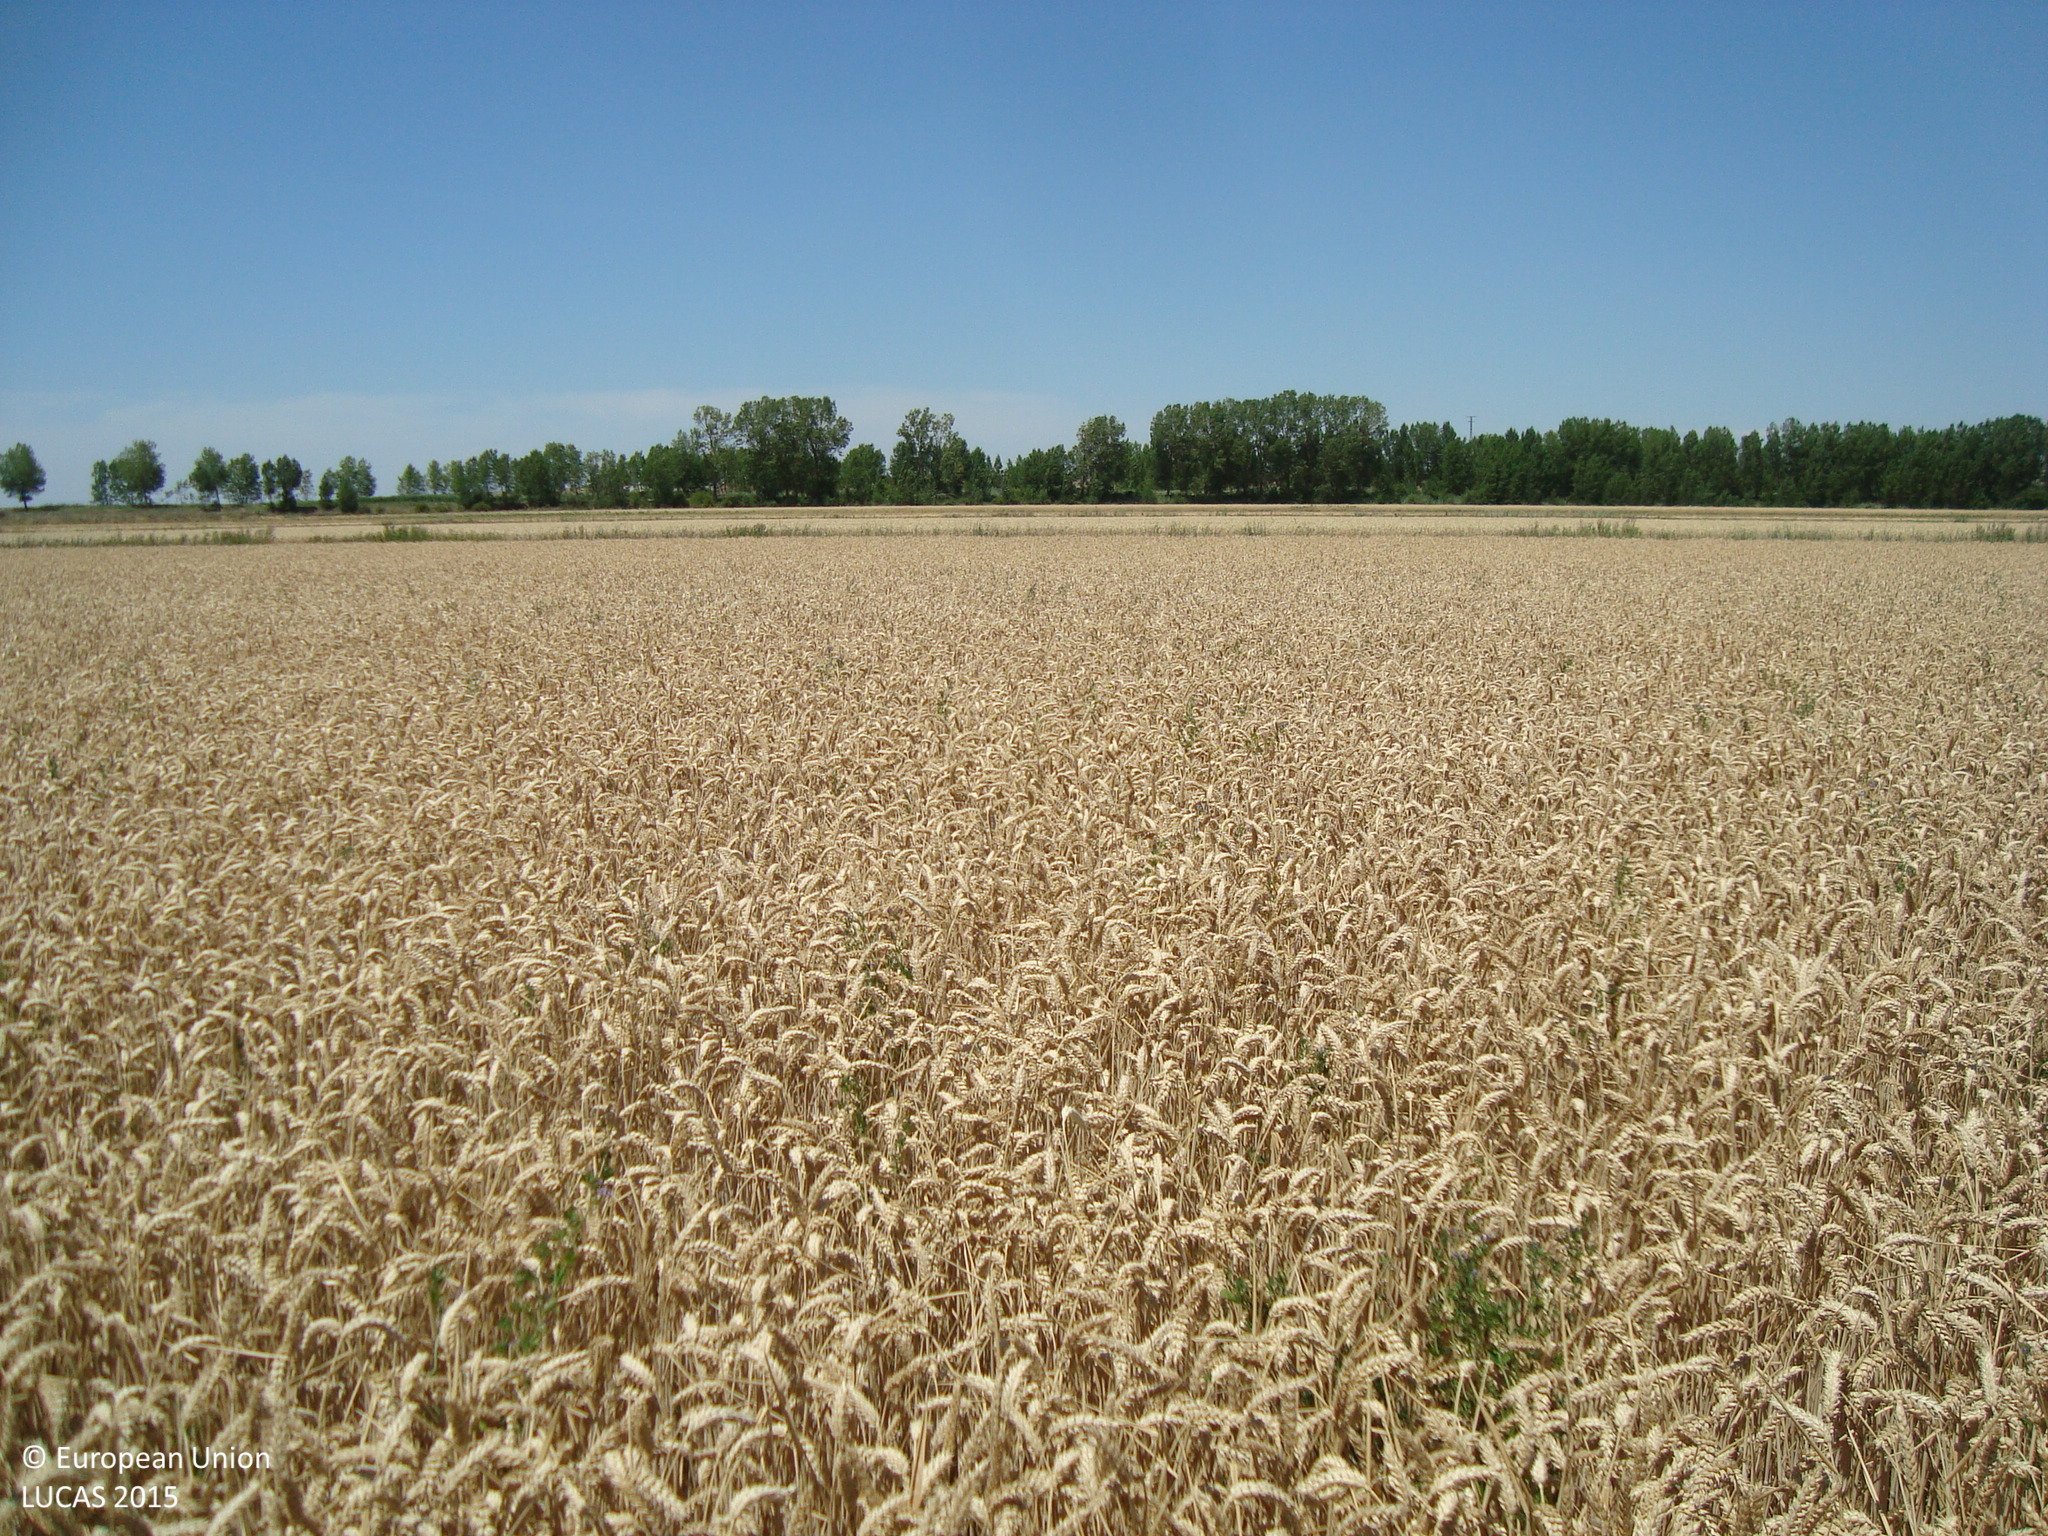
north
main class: Cropland
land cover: Common wheat
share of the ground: > 75 %
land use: Agriculture (excluding fallow land and kitchen gardens)
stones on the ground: < 10 %
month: July
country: ES
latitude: 42.1566
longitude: -4.7316
